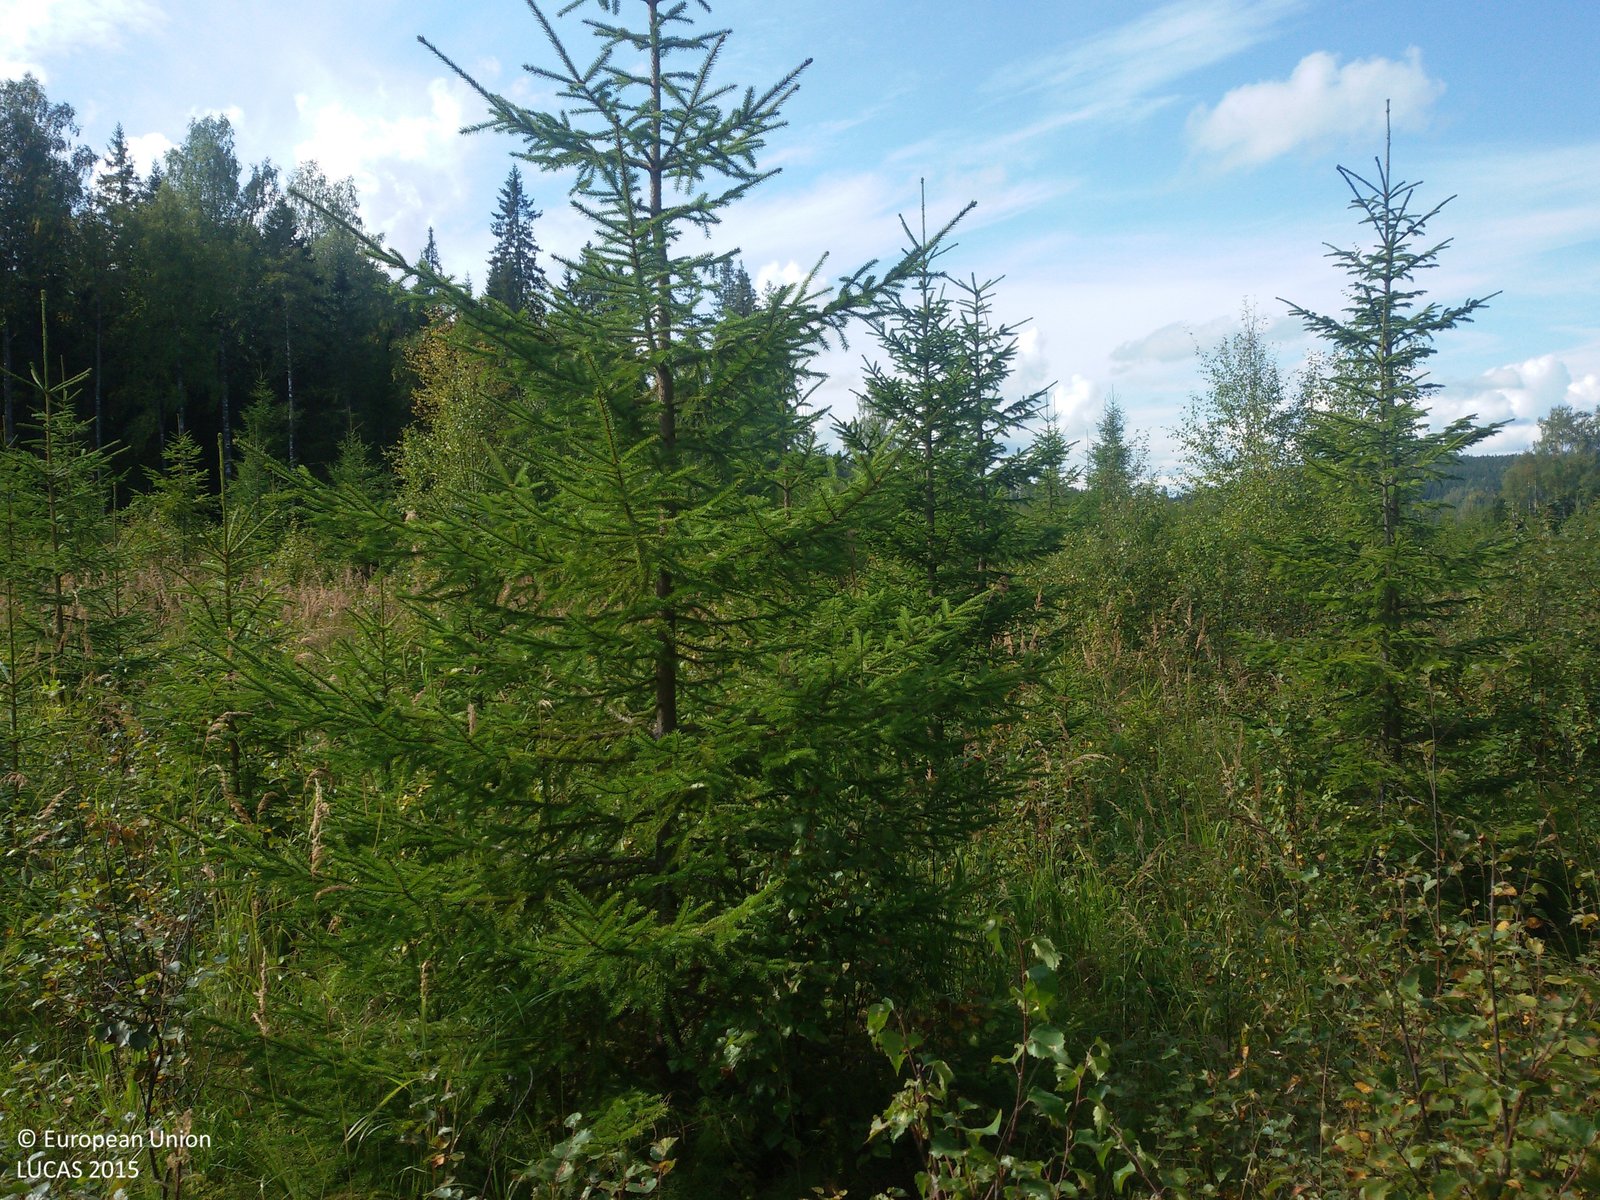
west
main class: Woodland
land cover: Spruce dominated mixed woodland
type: boreal forest
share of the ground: 25 - 50 %
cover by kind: herbaceous plants 60 %, coniferous forest trees 20 %, broadleaved forest trees 20 %
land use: Forestry
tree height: < 5 m
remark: Nursery
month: September
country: SE
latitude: 60.8902
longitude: 15.3855
